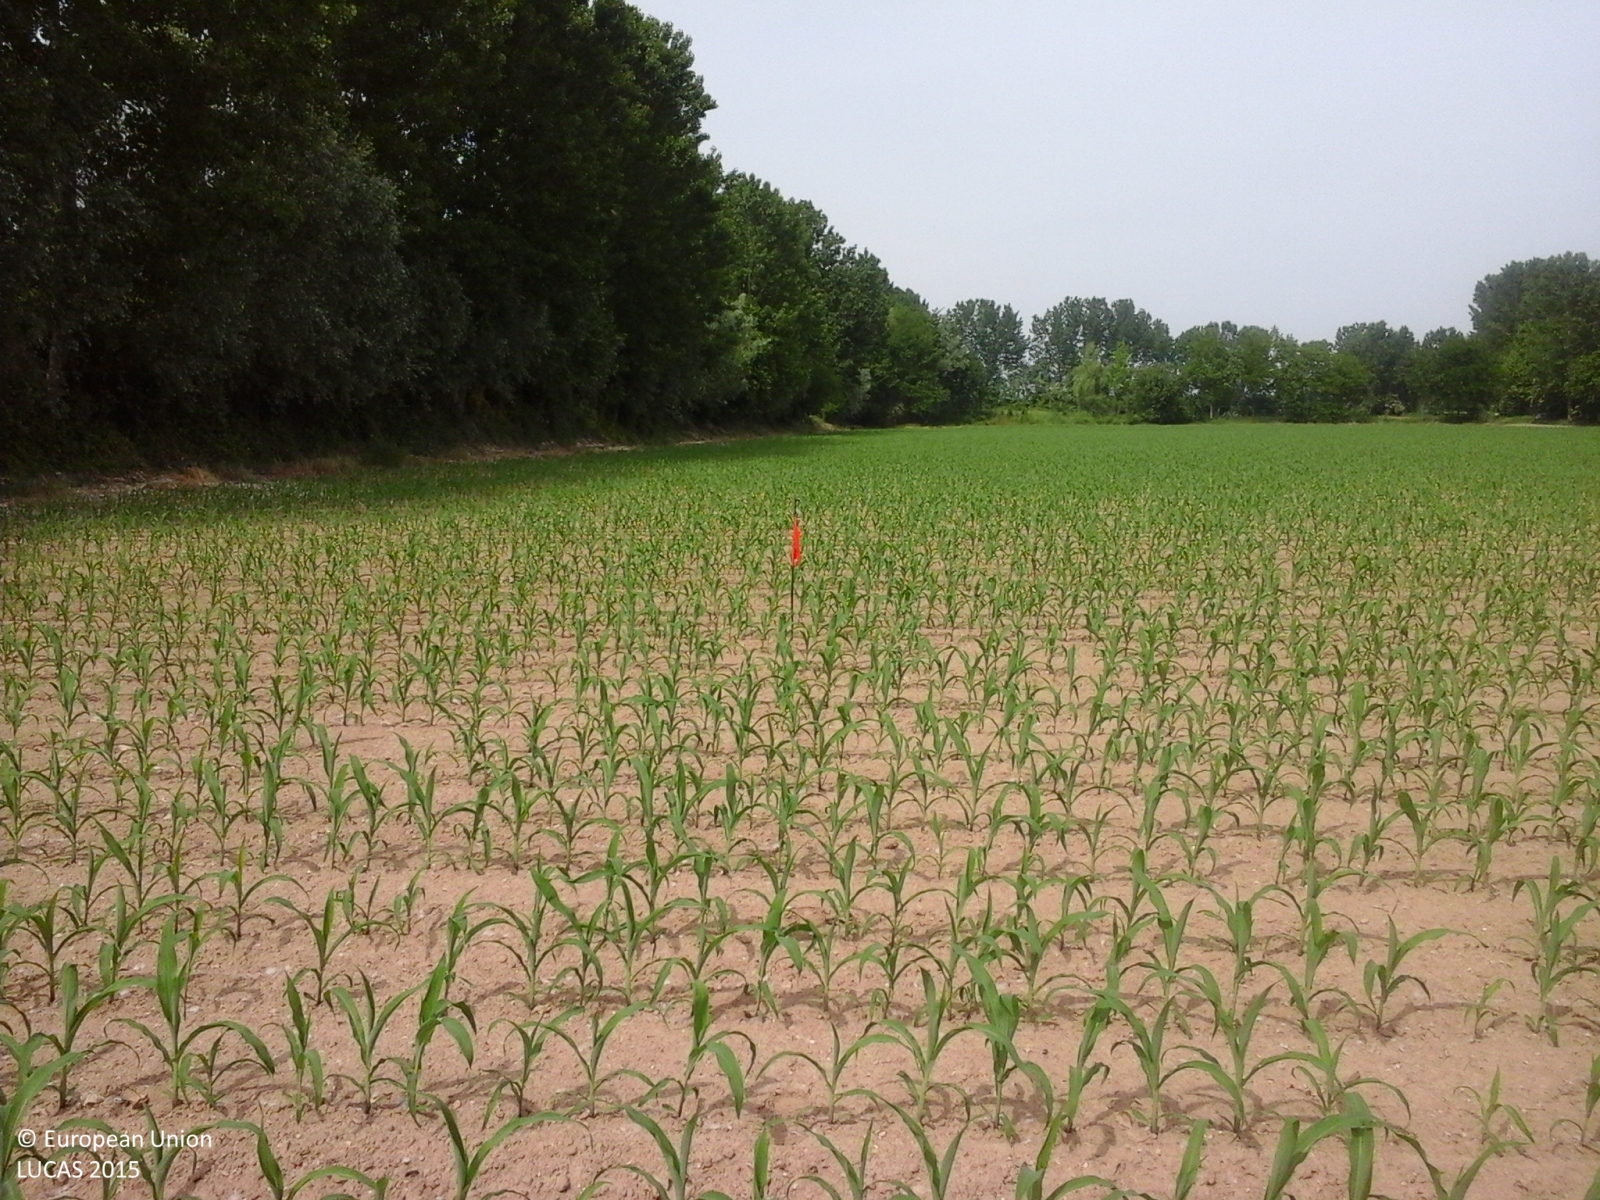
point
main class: Cropland
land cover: Maize
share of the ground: 25 - 50 %
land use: Agriculture (excluding fallow land and kitchen gardens)
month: May
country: IT
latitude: 45.2881
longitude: 10.0636
